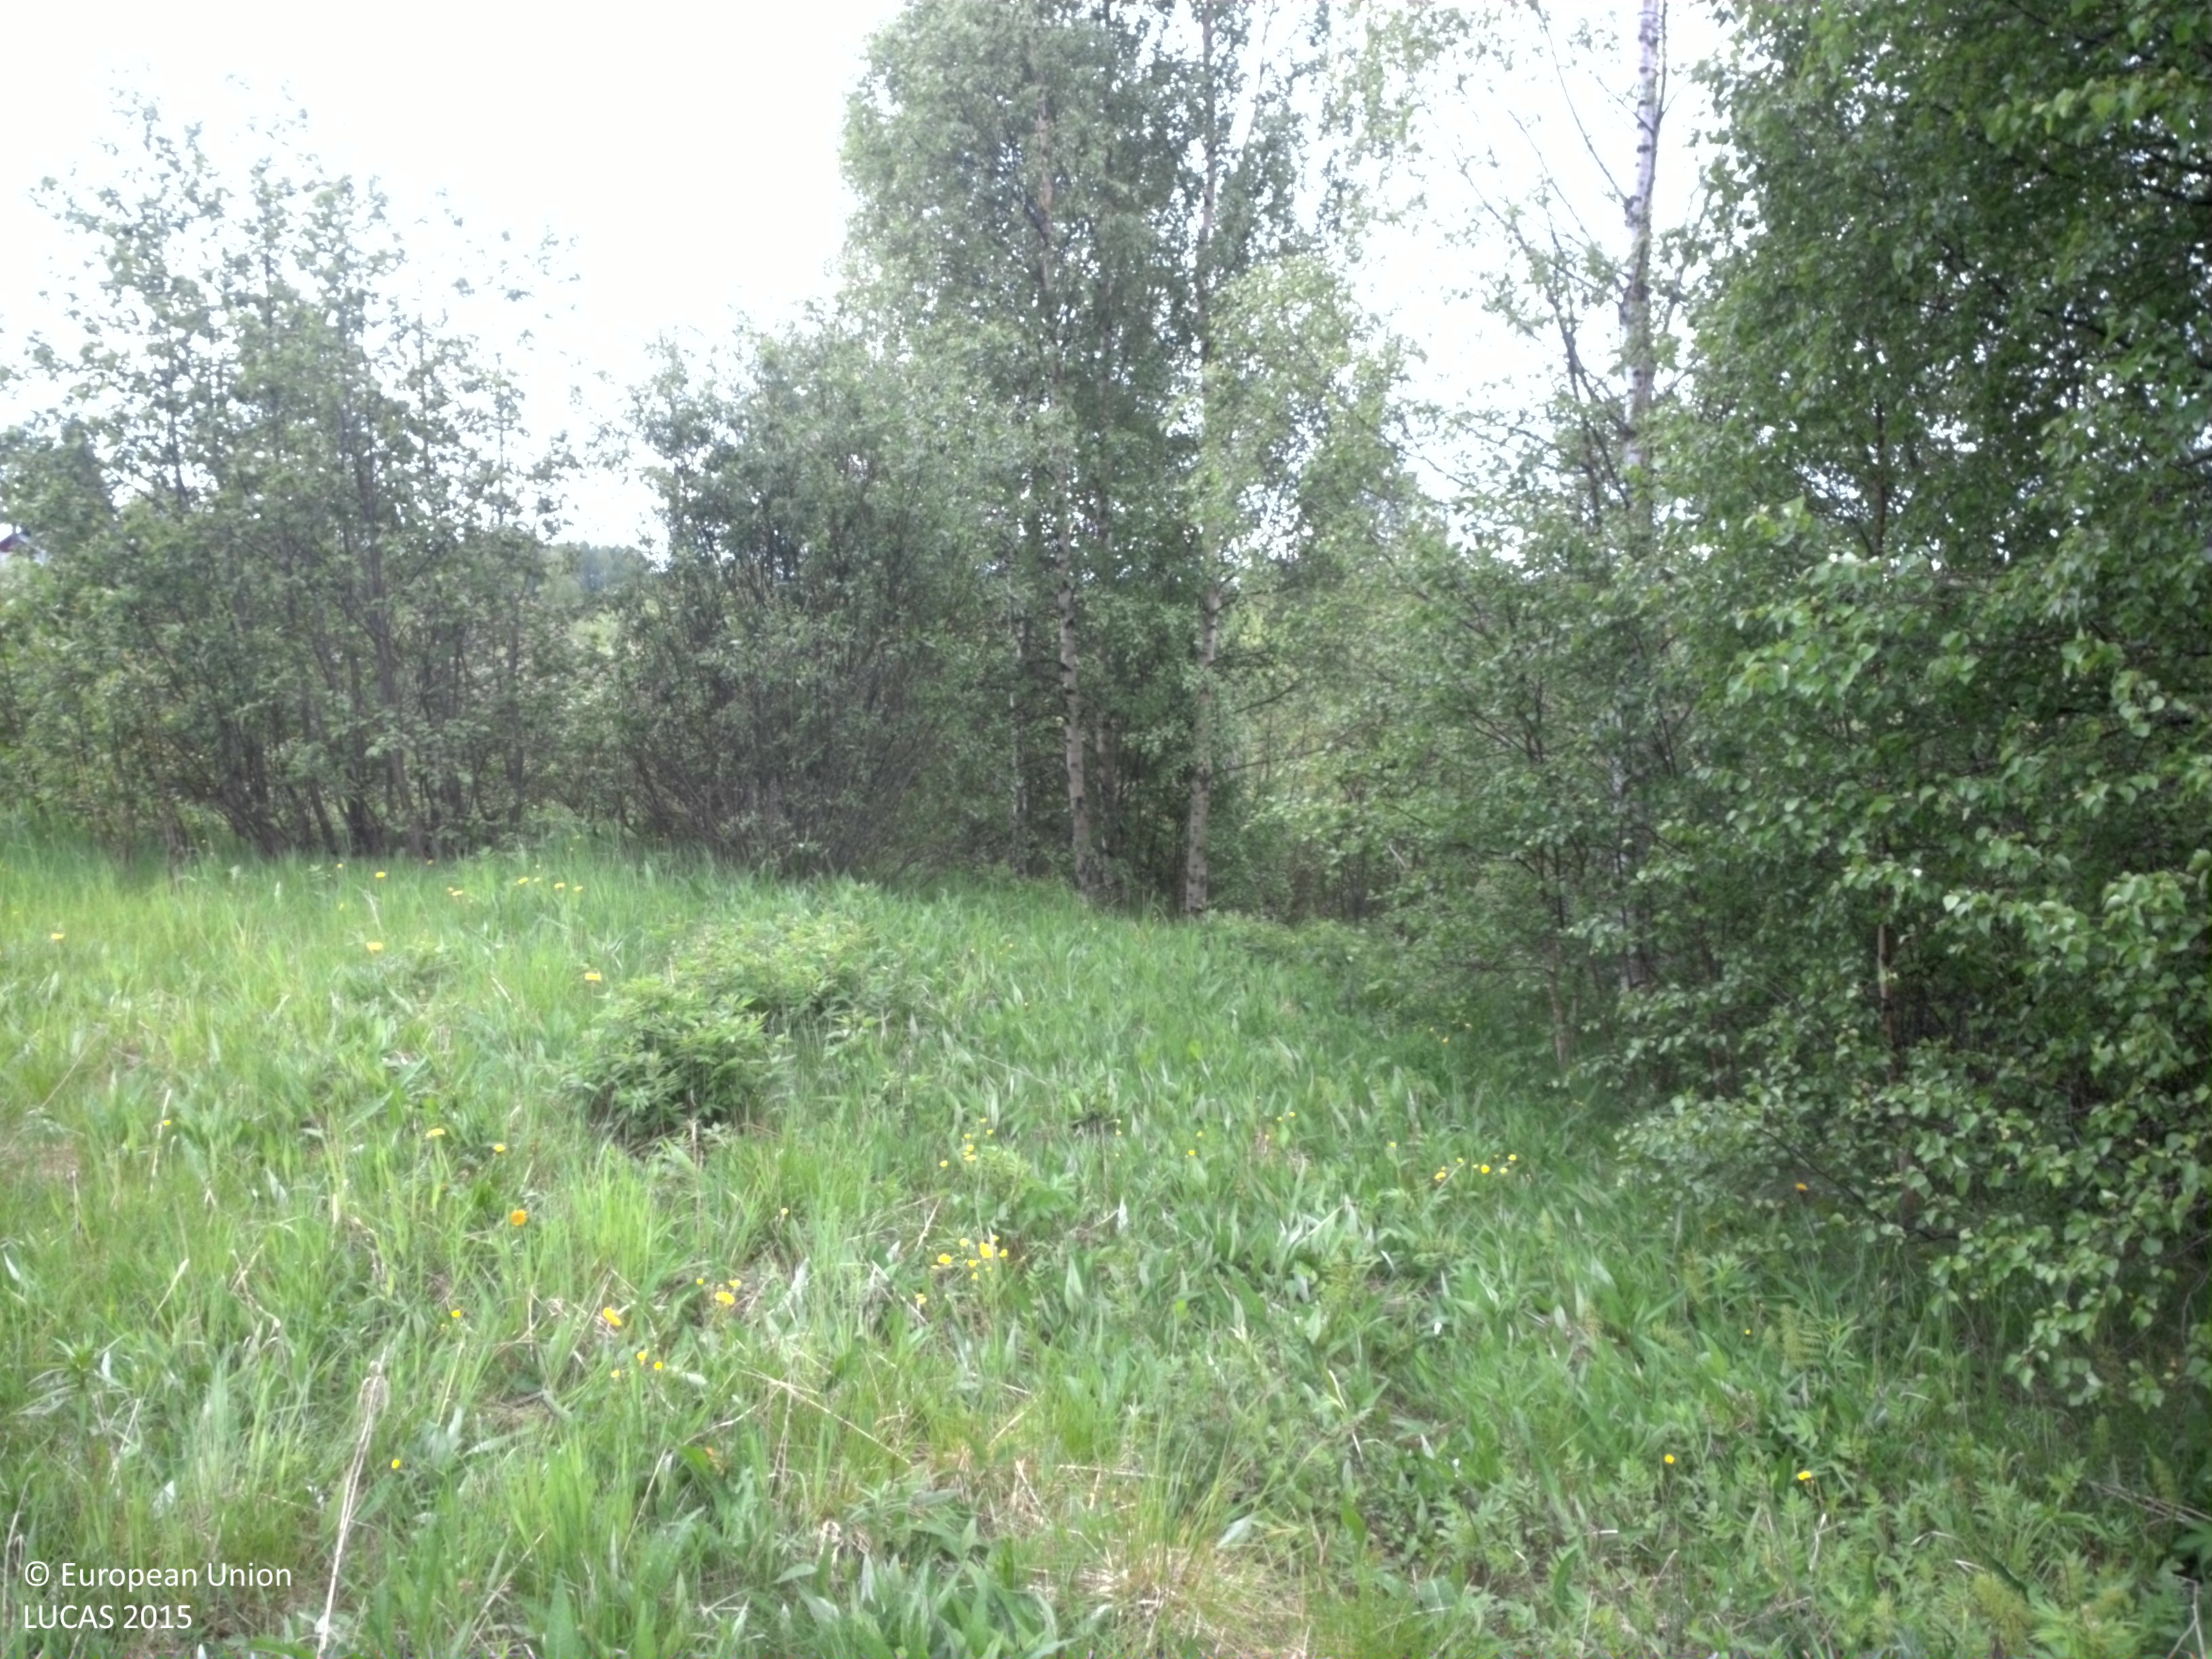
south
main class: Grassland
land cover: Grassland with sparse tree/shrub cover
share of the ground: > 75 %
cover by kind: herbaceous plants 95 %, broadleaved forest trees 5 %
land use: Agriculture (excluding fallow land and kitchen gardens)
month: June
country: SE
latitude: 64.1664
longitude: 20.6564
